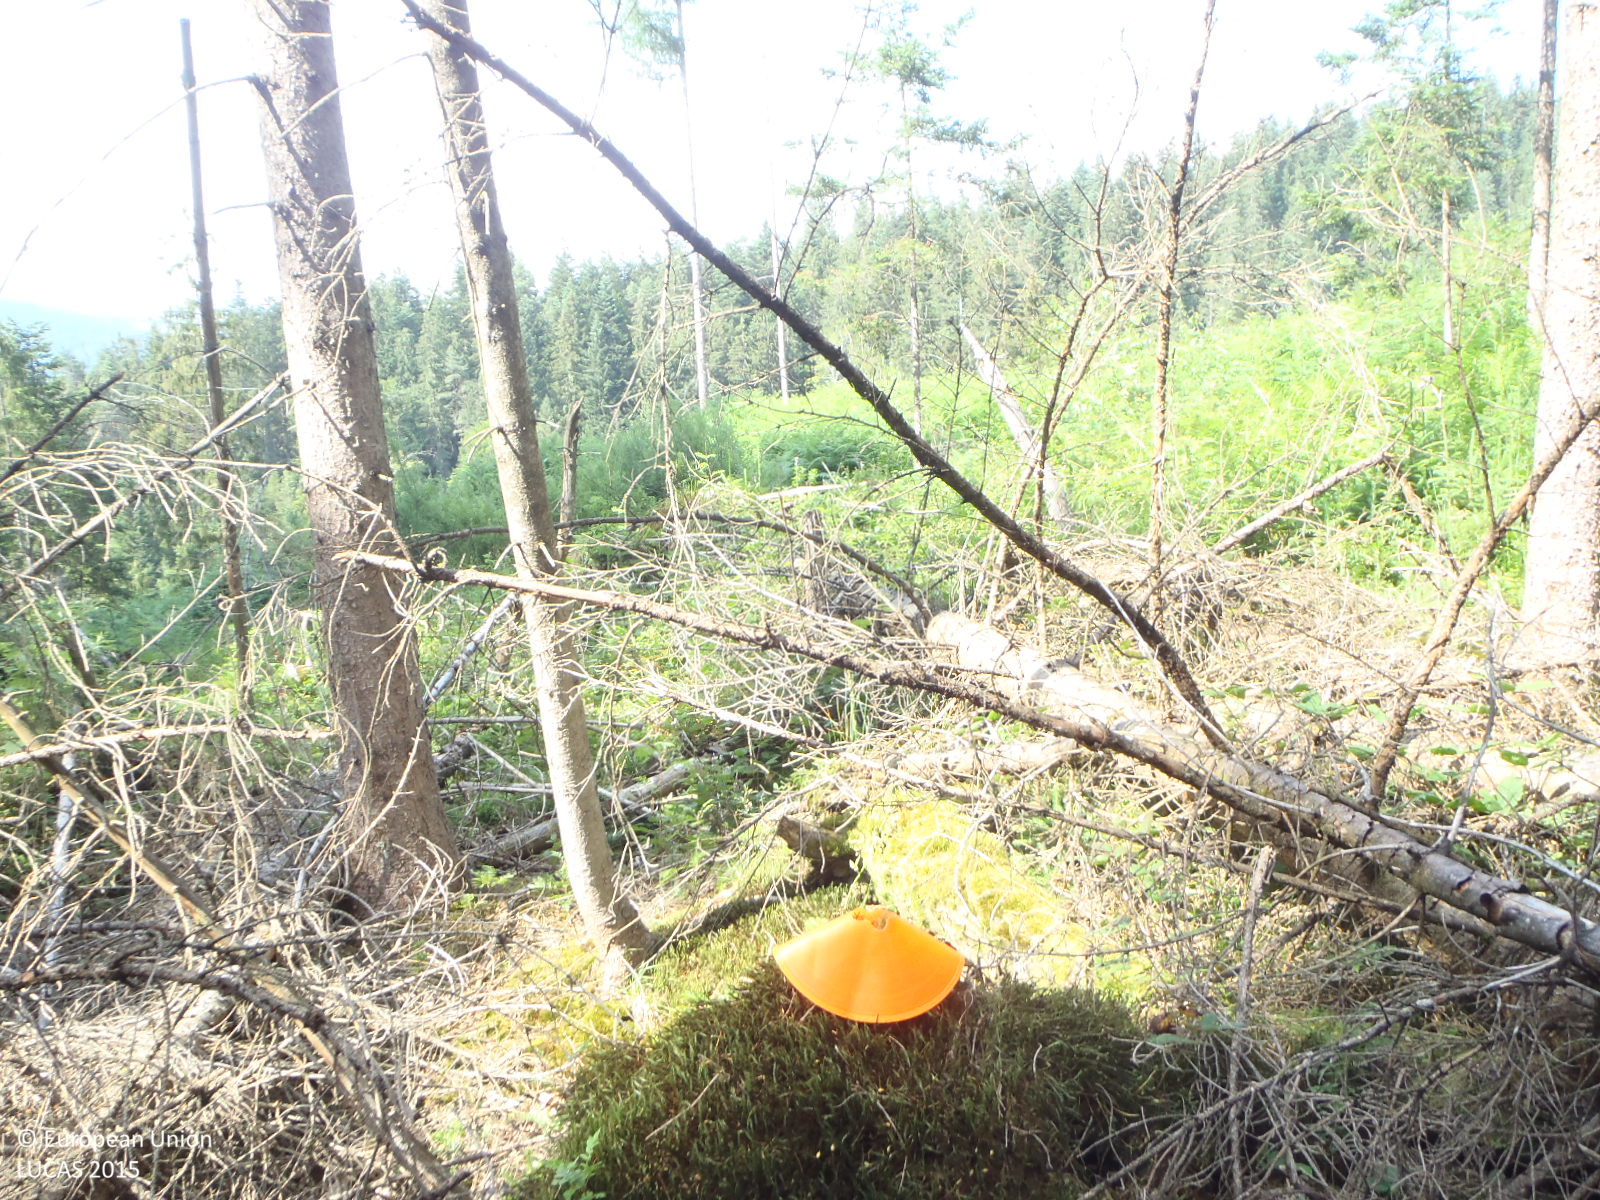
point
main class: Woodland
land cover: Spruce dominated coniferous woodland
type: alpine coniferous forest
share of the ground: 50 - 75 %
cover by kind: coniferous forest trees 60 %, herbaceous plants 20 %, shrubs 10 %, broadleaved forest trees 5 %, lichens and mosses 5 %
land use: Forestry
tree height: > 5 m
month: July
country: AT
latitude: 47.5300
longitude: 12.4557
